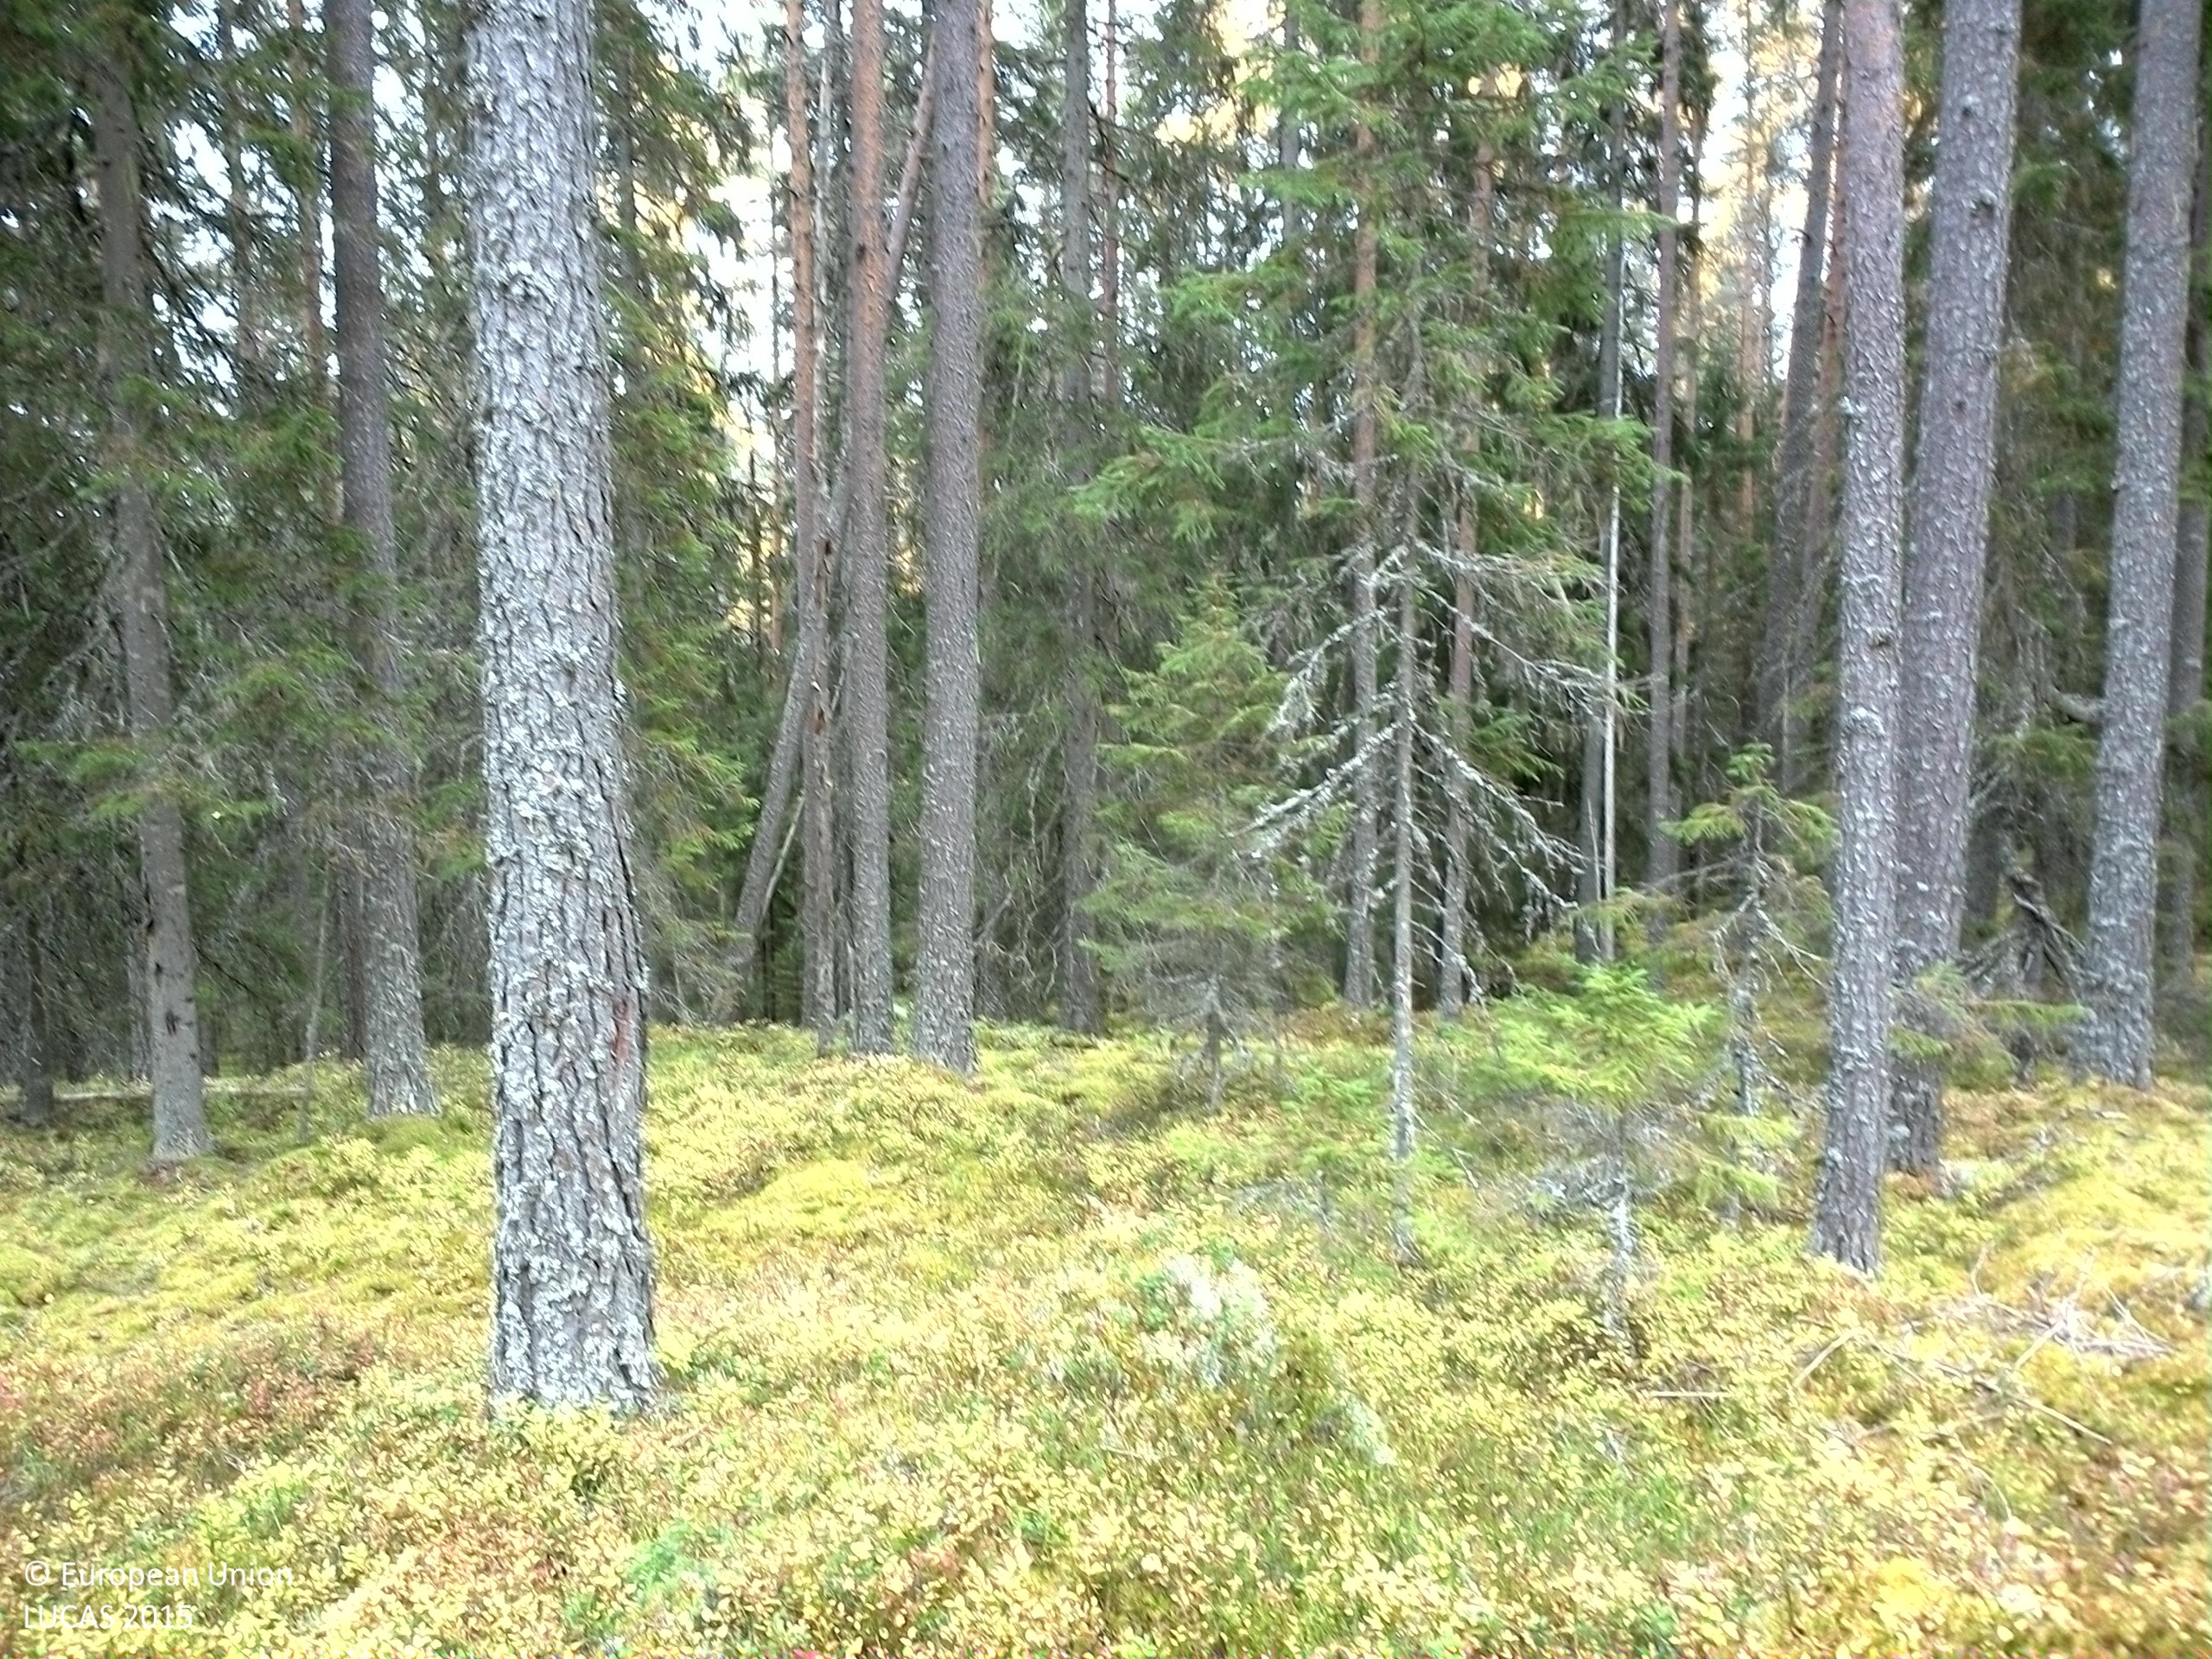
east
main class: Woodland
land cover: Pine dominated coniferous woodland
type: boreal forest
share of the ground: 50 - 75 %
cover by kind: coniferous forest trees 55 %, shrubs 25 %, lichens and mosses 20 %
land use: Forestry
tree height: > 5 m
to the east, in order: Pine dominated coniferous woodland; Other coniferous woodland; Pine dominated coniferous woodland
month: October
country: SE
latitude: 61.2326
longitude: 14.3263
